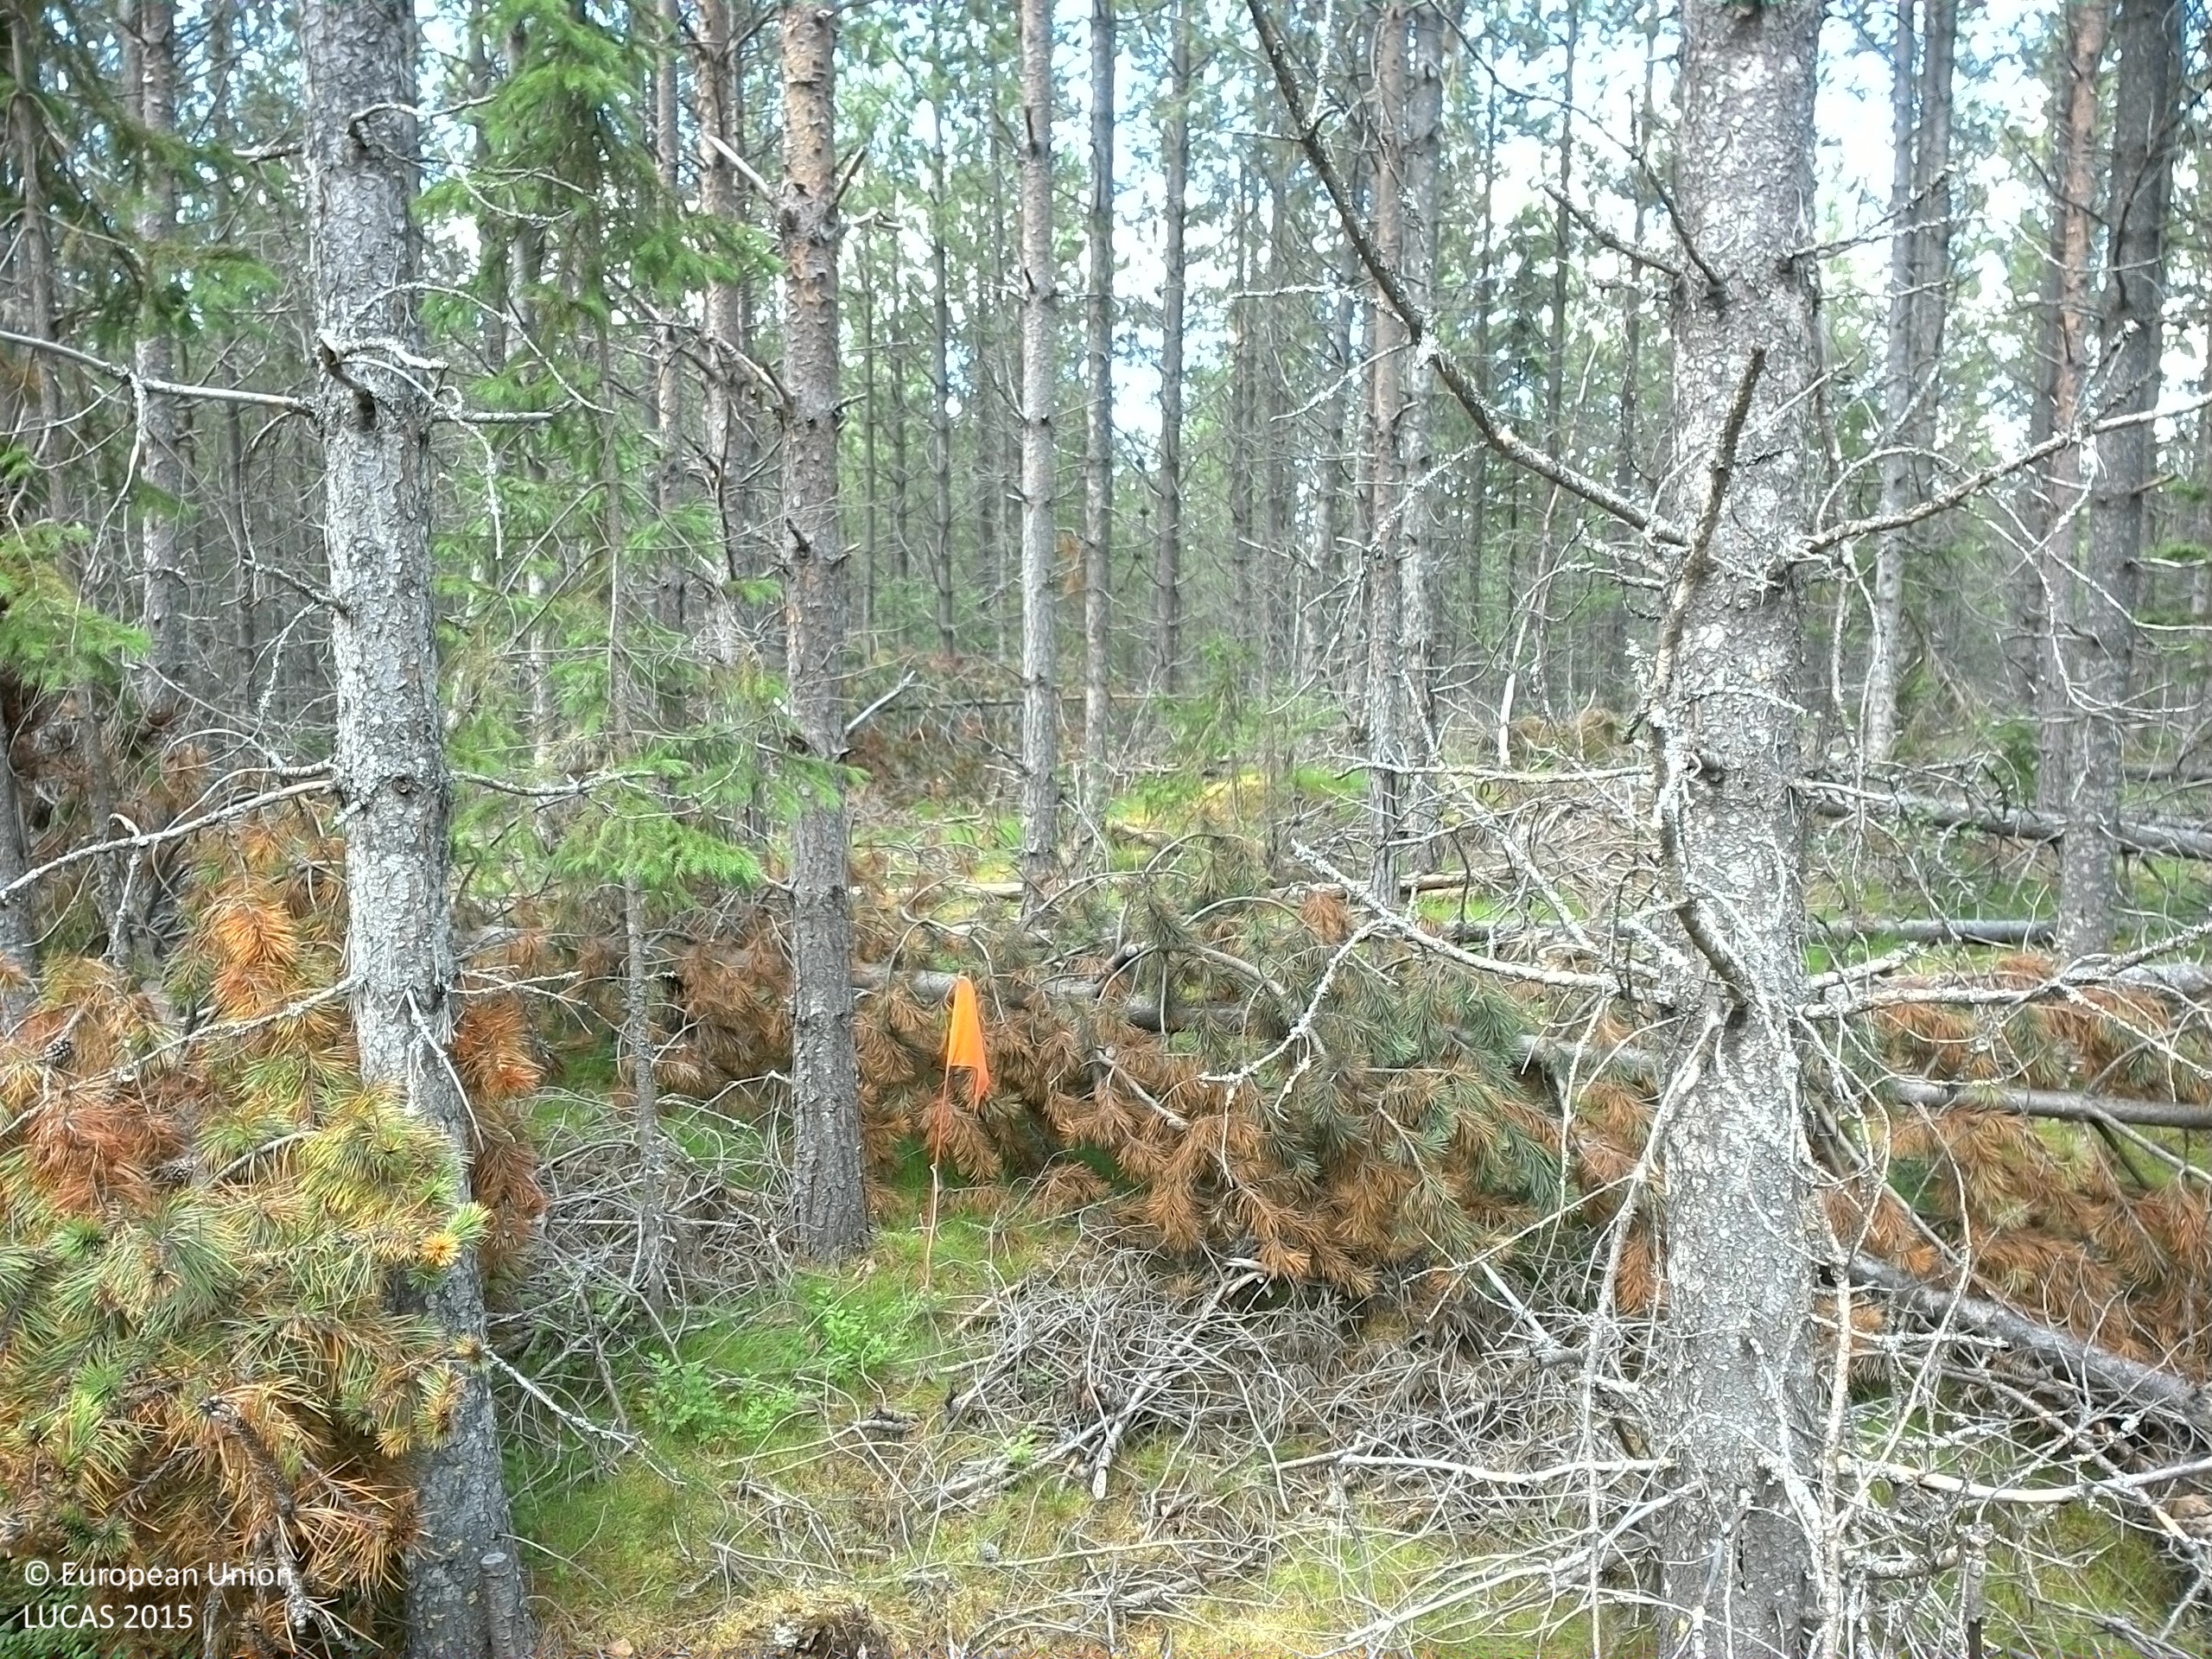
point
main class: Woodland
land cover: Pine dominated coniferous woodland
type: exotic forest
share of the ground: > 75 %
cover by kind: coniferous forest trees 75 %, herbaceous plants 10 %, lichens and mosses 10 %, shrubs 5 %
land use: Forestry
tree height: > 5 m
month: August
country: SE
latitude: 62.9034
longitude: 16.5694
